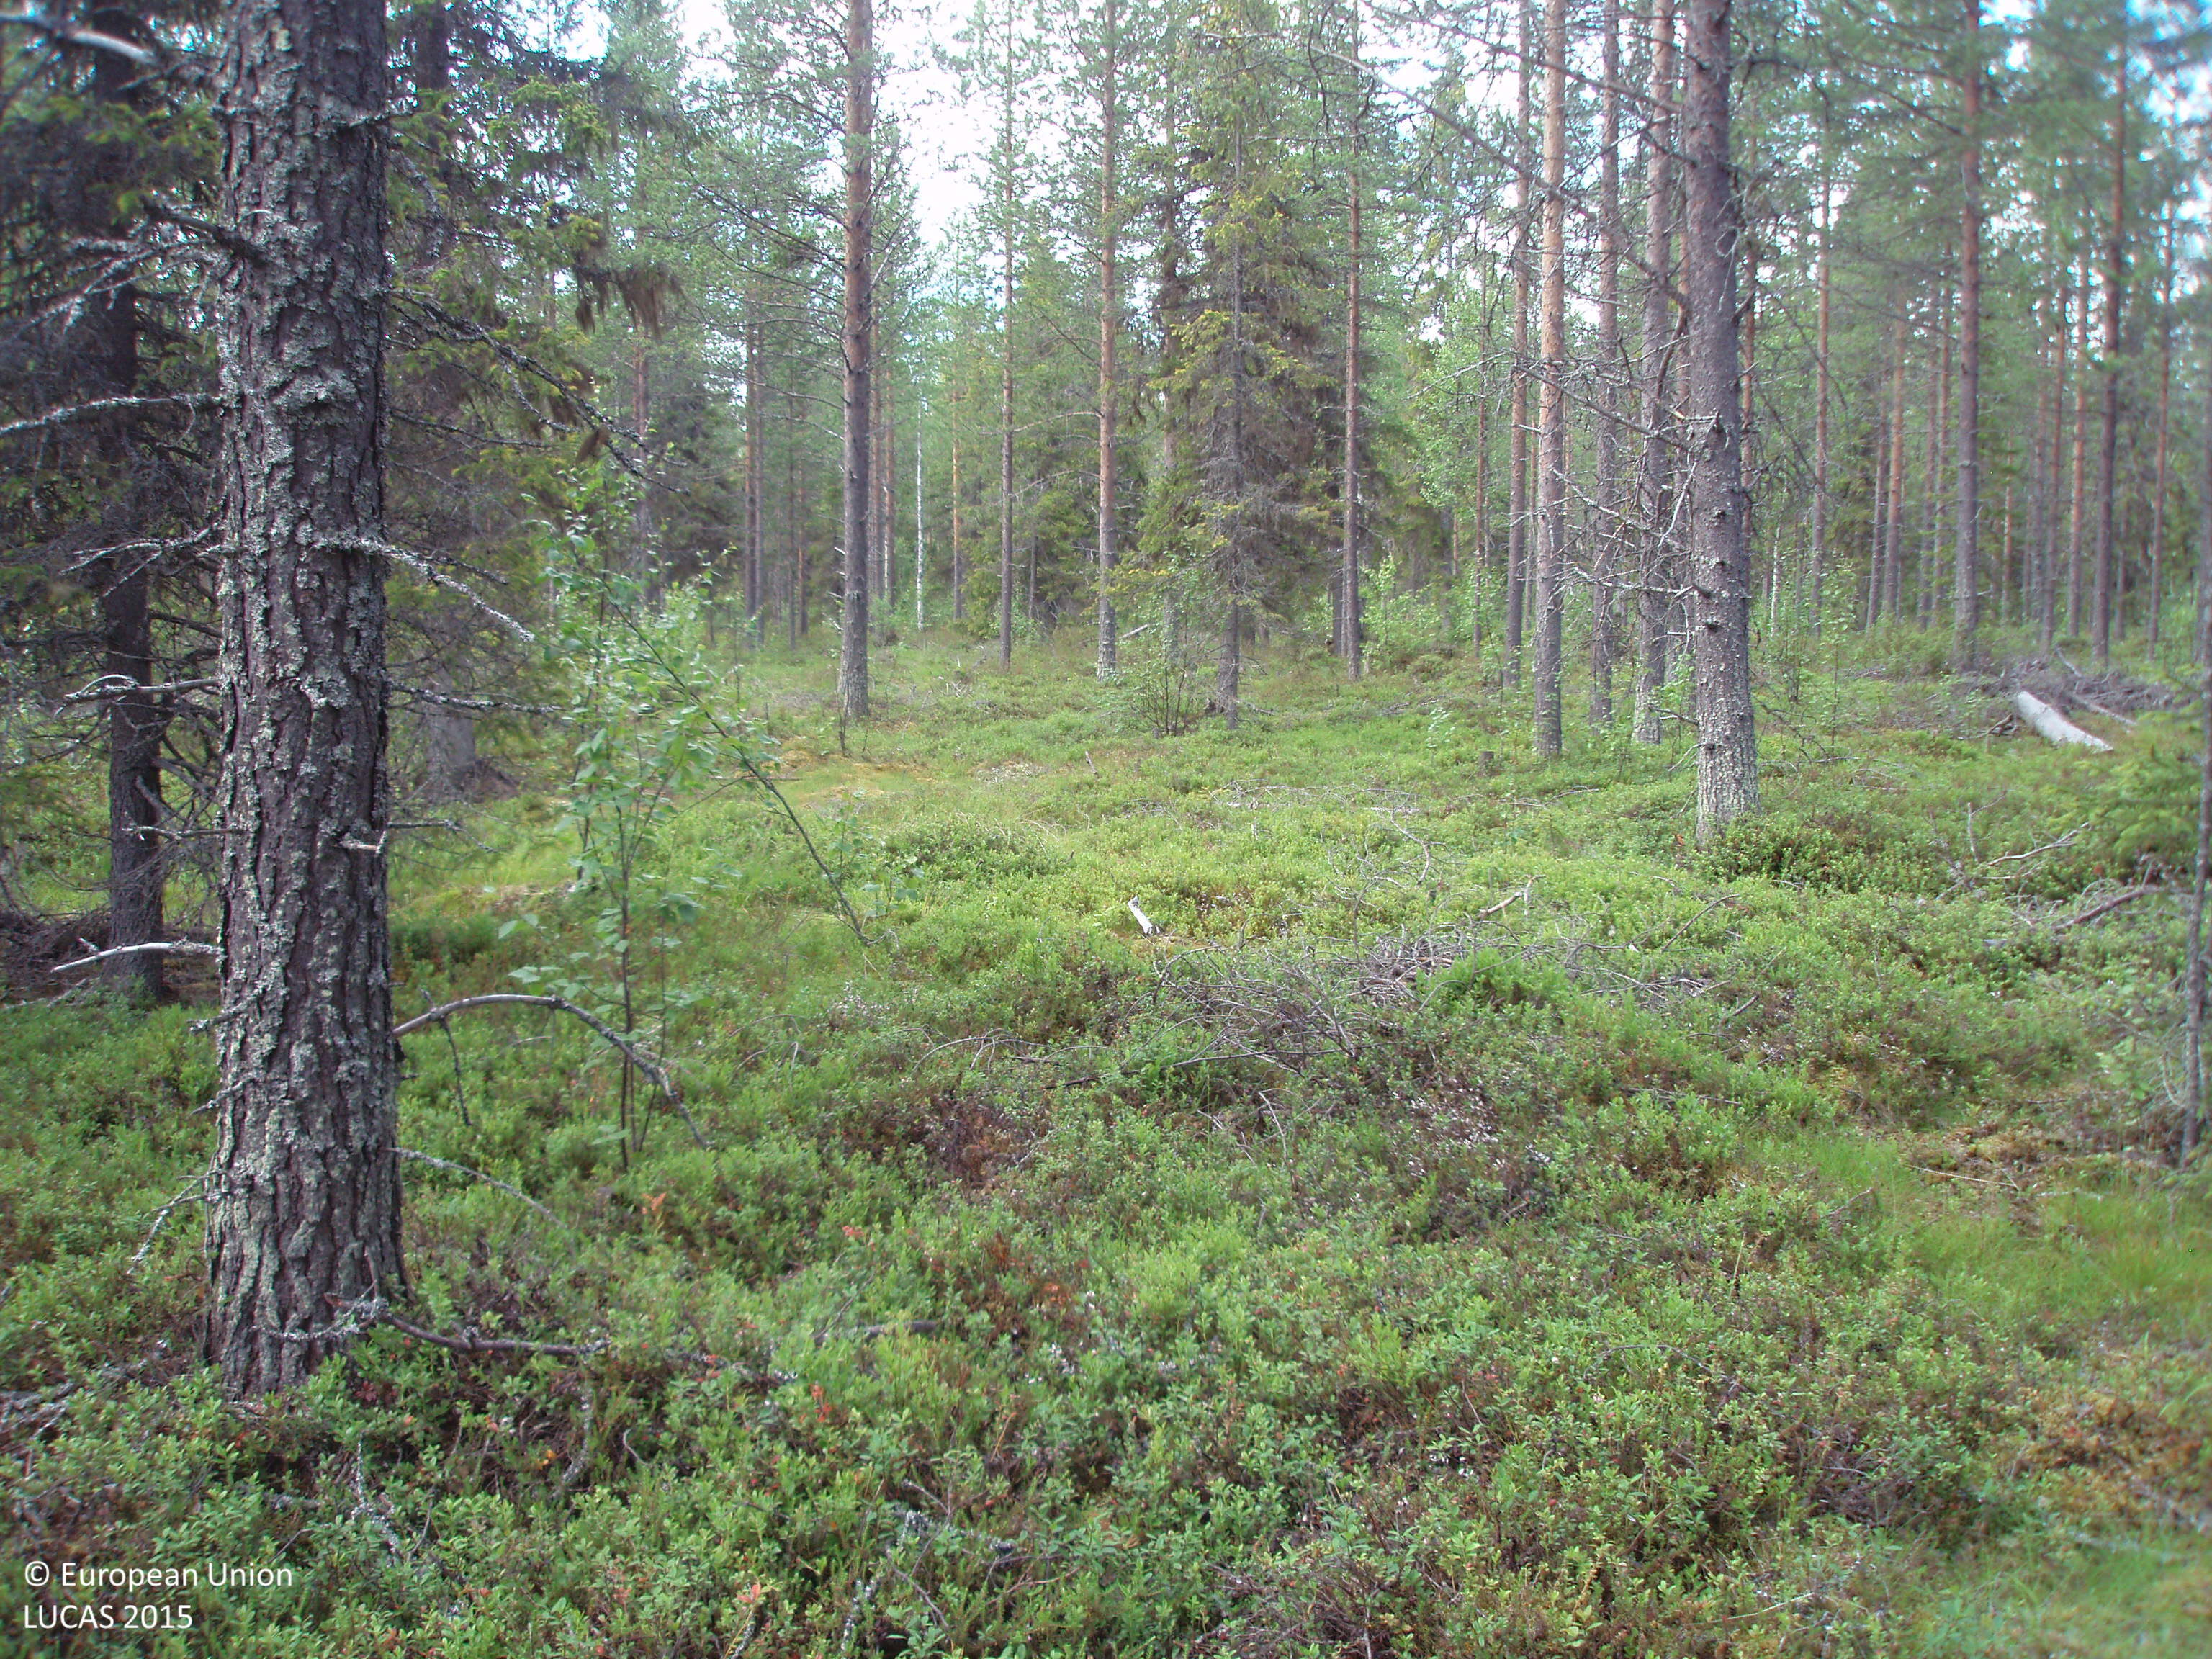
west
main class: Woodland
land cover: Pine dominated coniferous woodland
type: boreal forest
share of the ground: 50 - 75 %
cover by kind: coniferous forest trees 60 %, shrubs 40 %
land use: Forestry
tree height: > 5 m
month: July
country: FI
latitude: 66.9623
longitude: 28.1481
